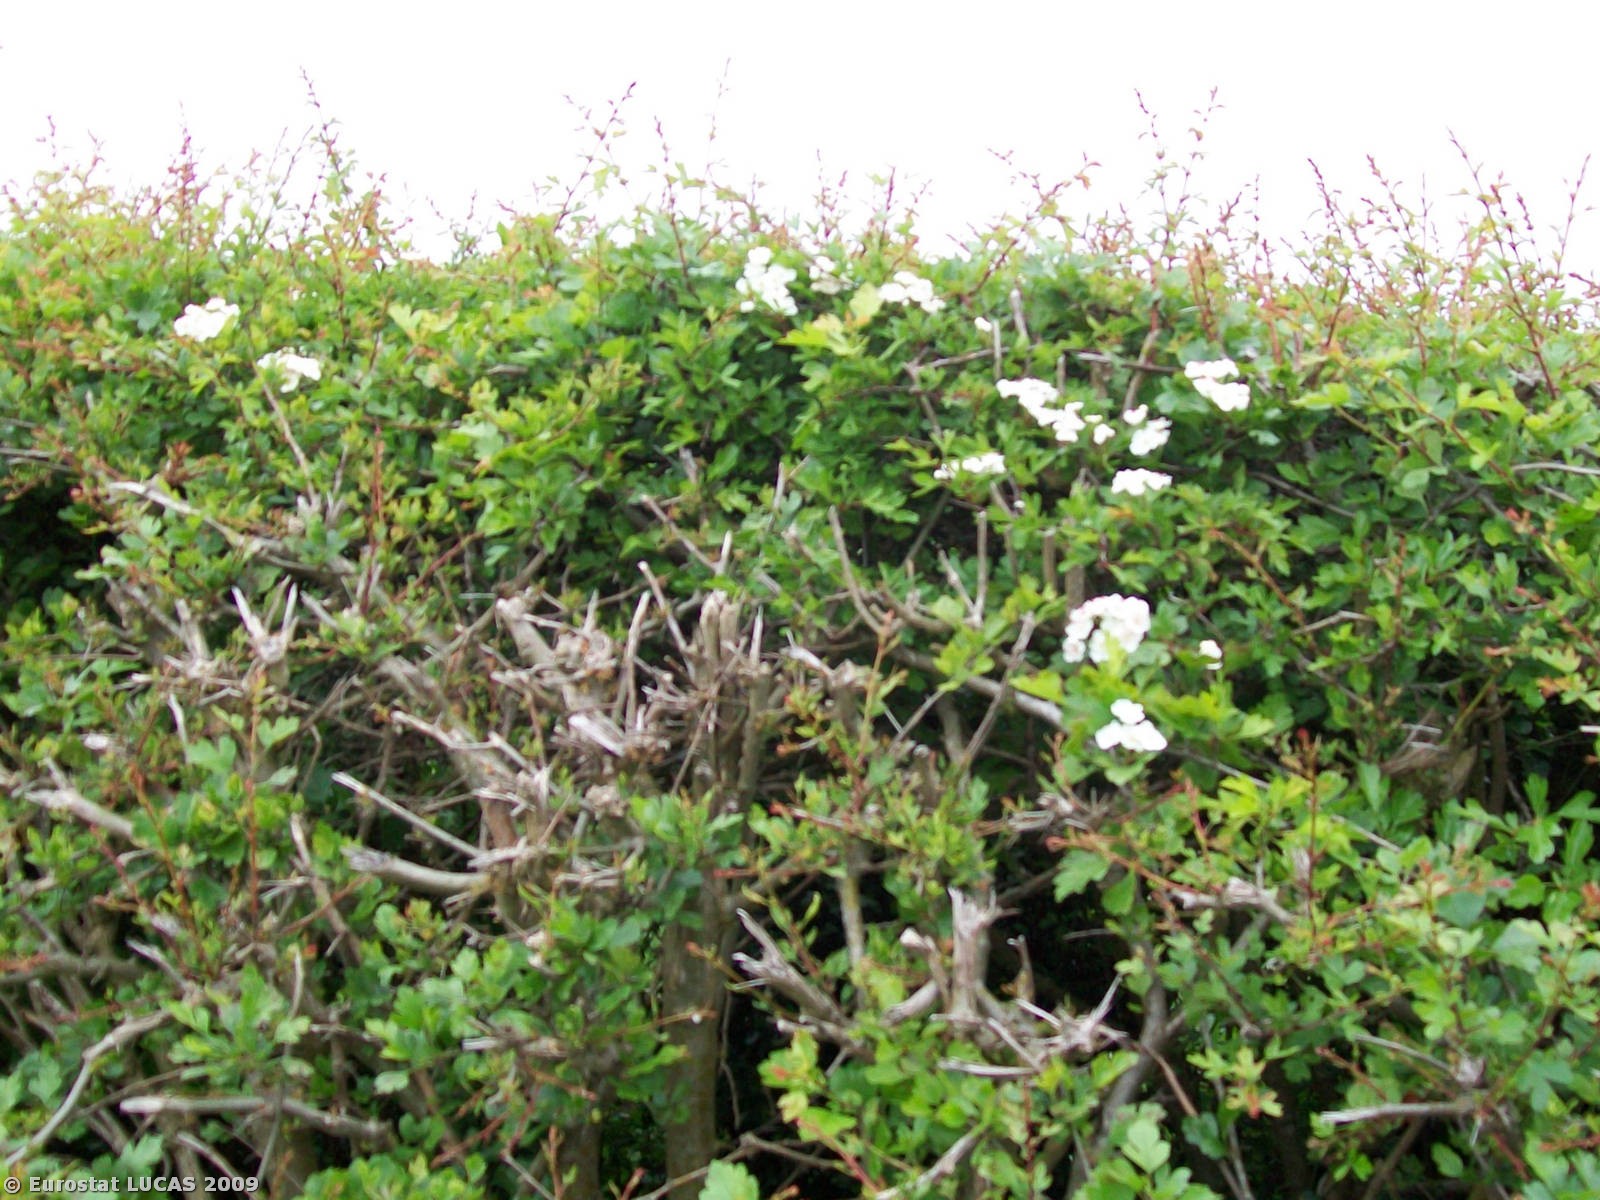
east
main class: Cropland
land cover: Common wheat
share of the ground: > 75 %
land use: Agriculture (excluding fallow land and kitchen gardens)
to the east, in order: Common wheat; Grass margins; Managed hedges; Grass margins; Common wheat
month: May
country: GB
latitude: 52.8035
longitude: -0.8556
